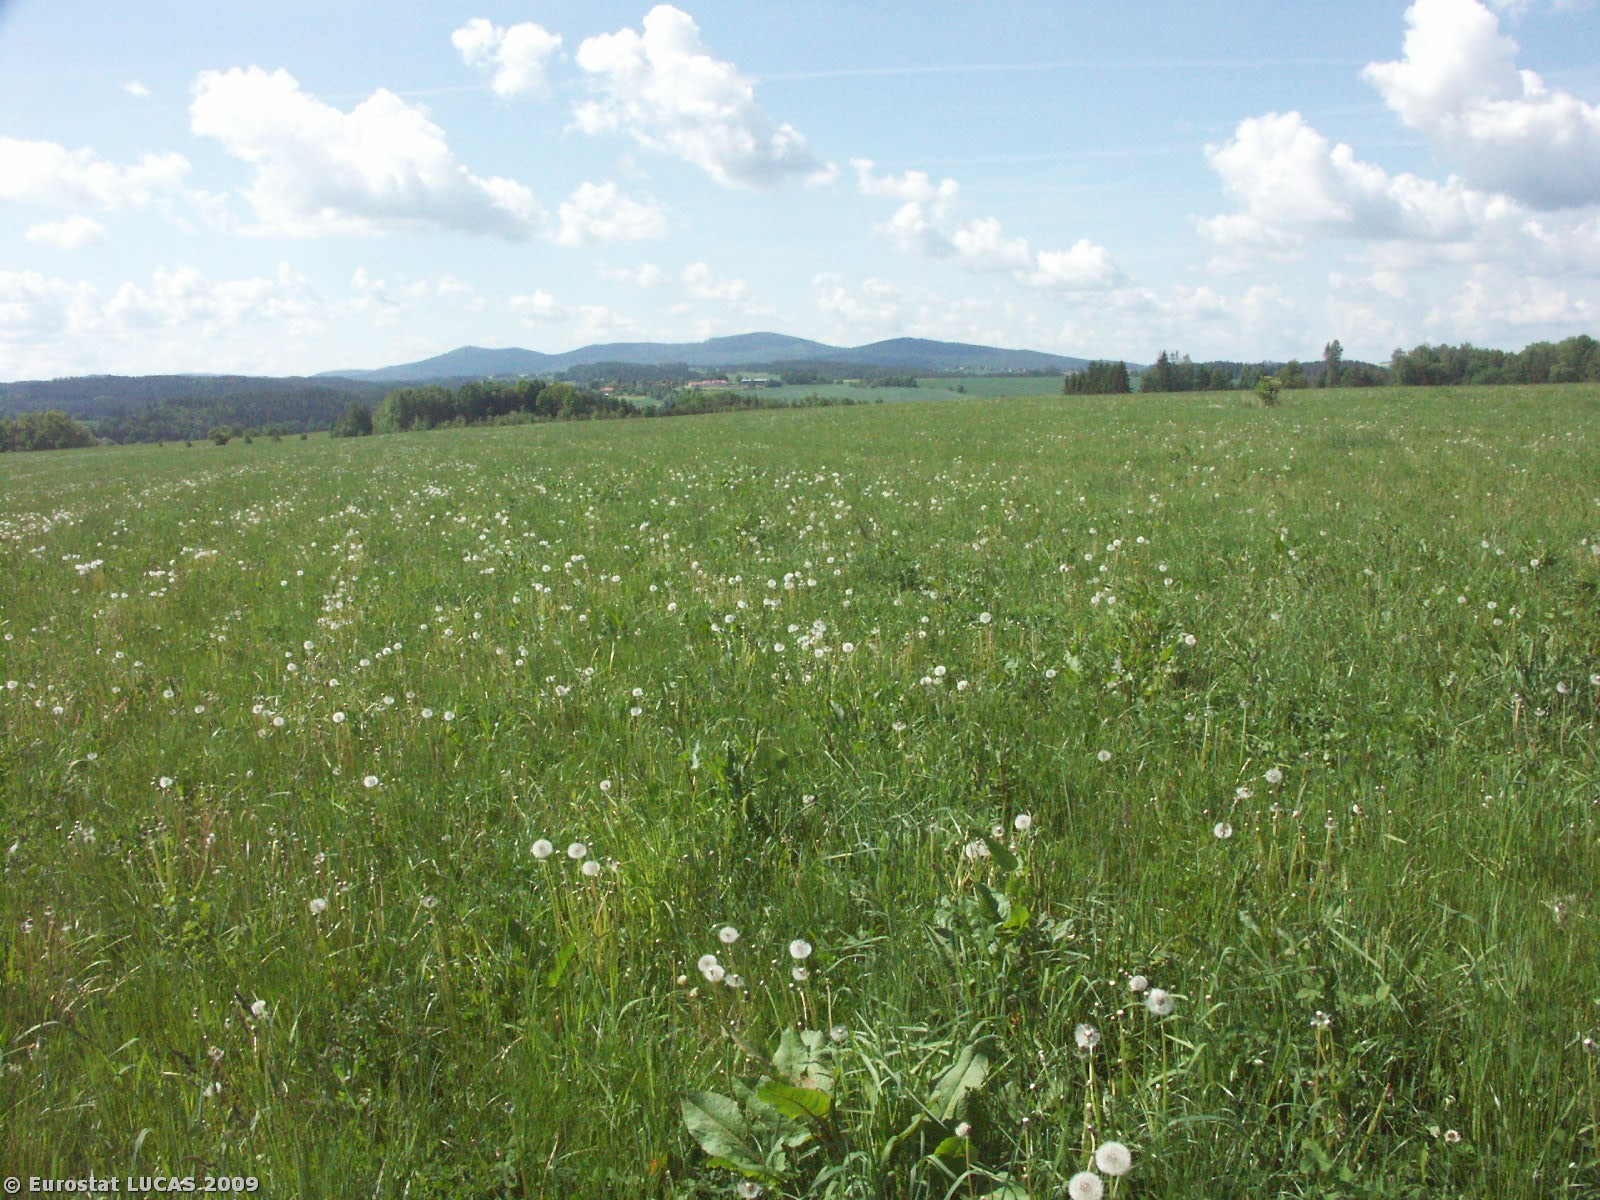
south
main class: Grassland
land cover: Grassland without tree/shrub cover
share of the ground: > 75 %
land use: Agriculture (excluding fallow land and kitchen gardens)
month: May
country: CZ
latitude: 48.8476
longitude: 14.6209
